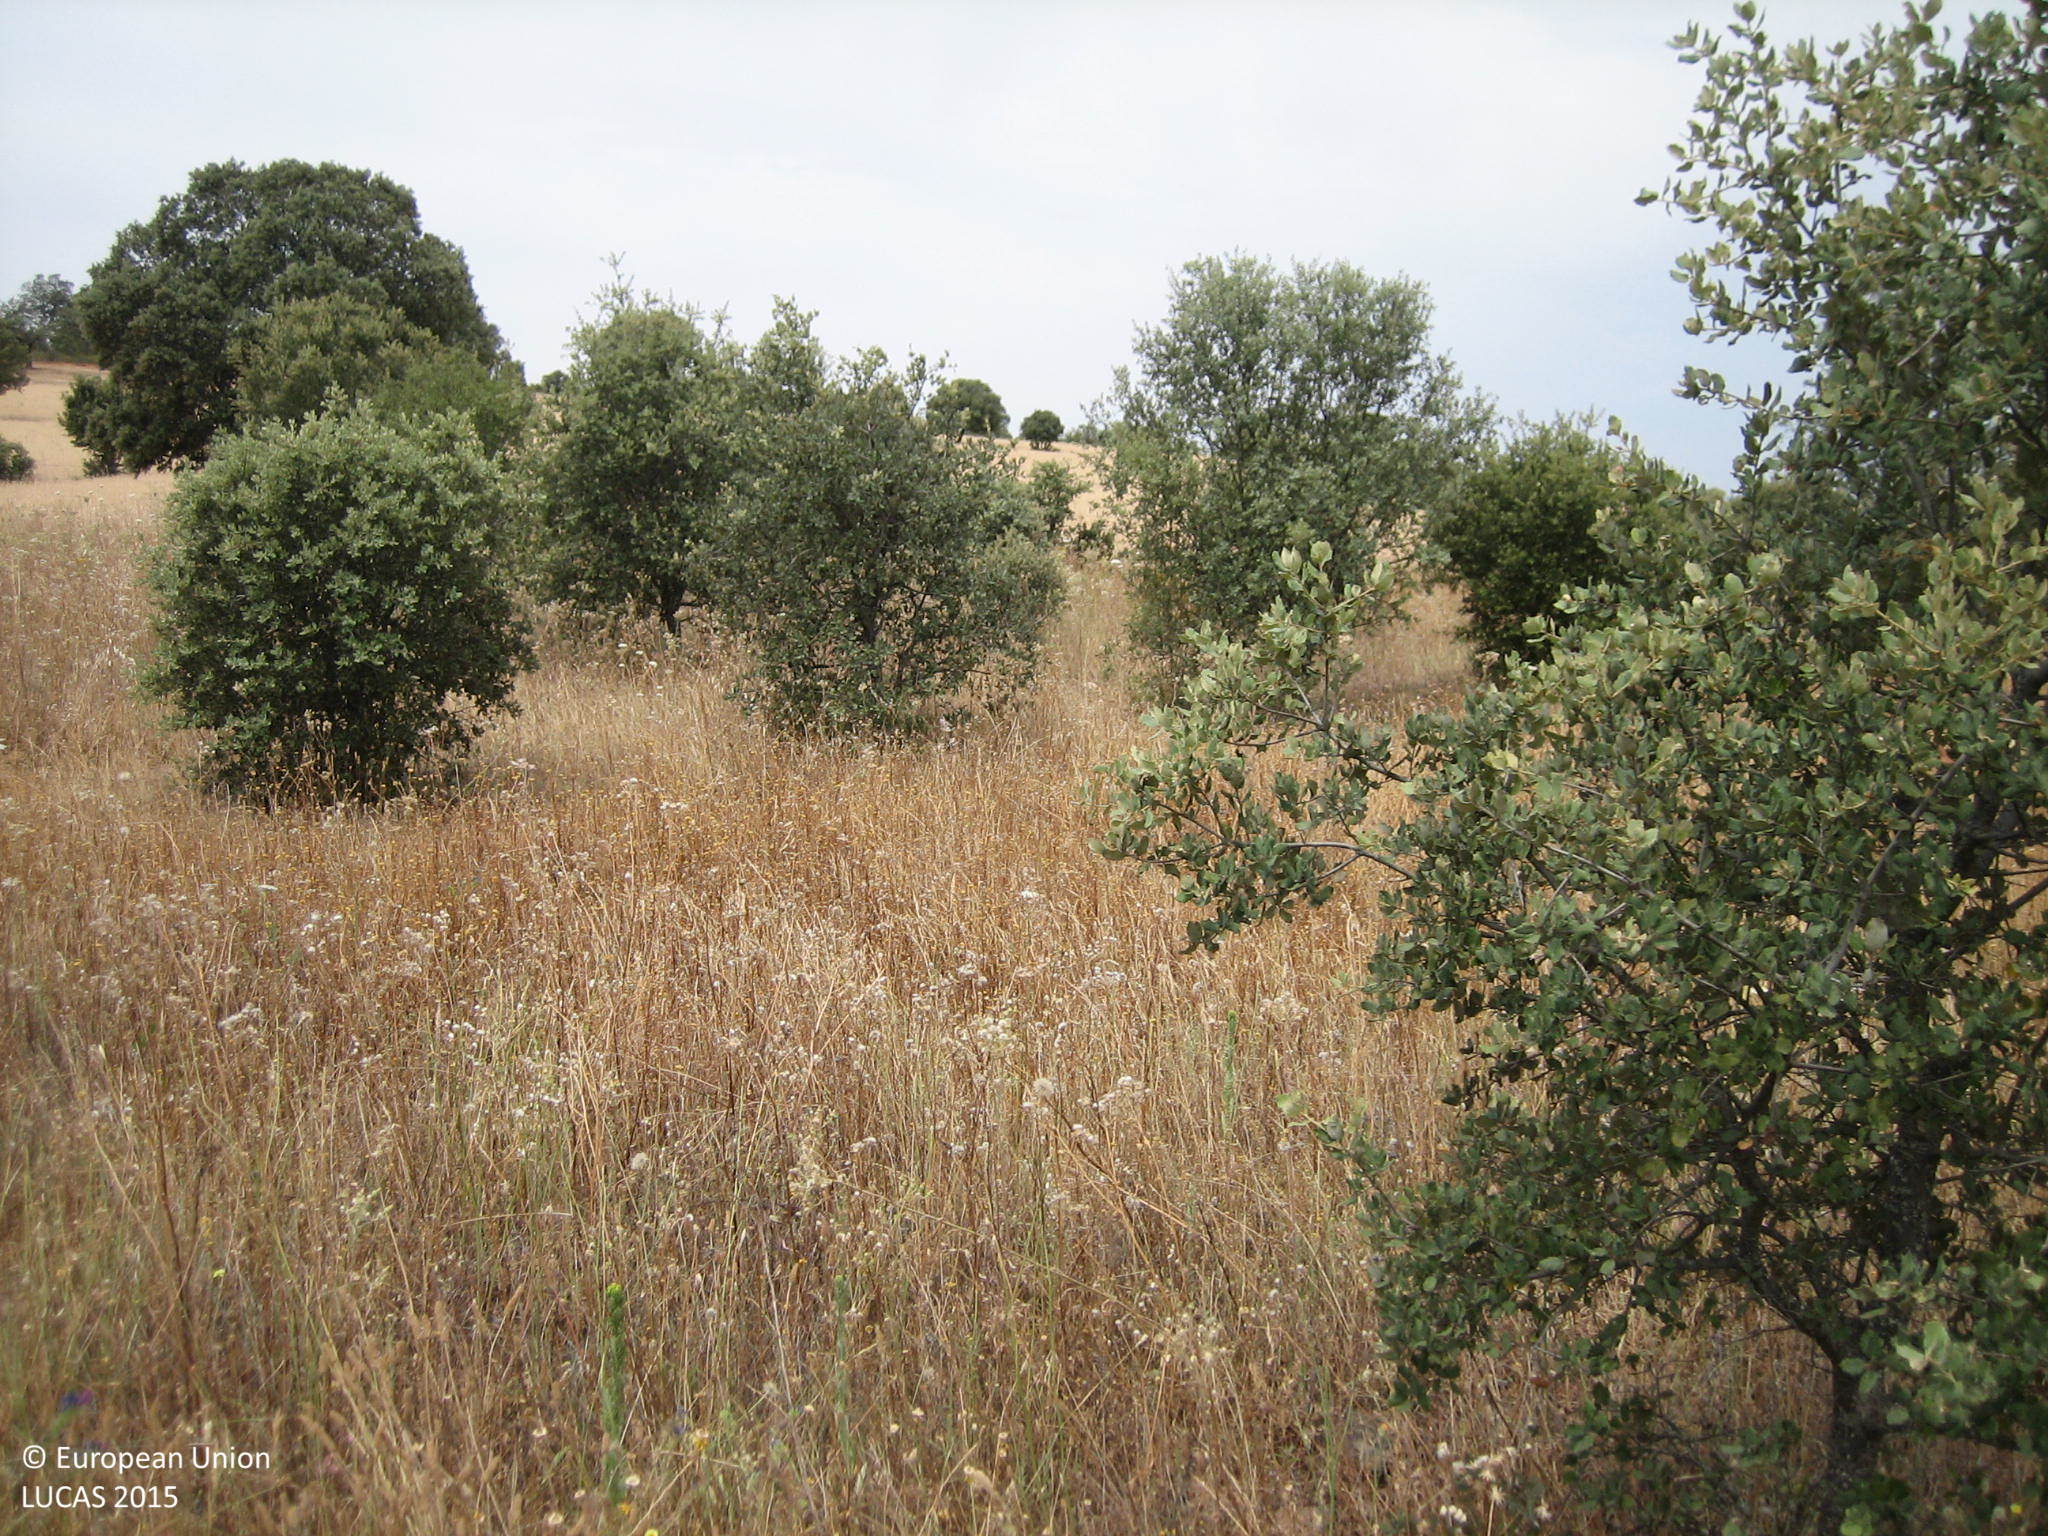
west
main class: Woodland
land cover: Broadleaved woodland
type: broadleaved evergreen forest
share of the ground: 25 - 50 %
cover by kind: herbaceous plants 60 %, broadleaved forest trees 40 %
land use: Forestry
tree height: < 5 m
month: June
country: ES
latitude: 39.1818
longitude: -4.5133
